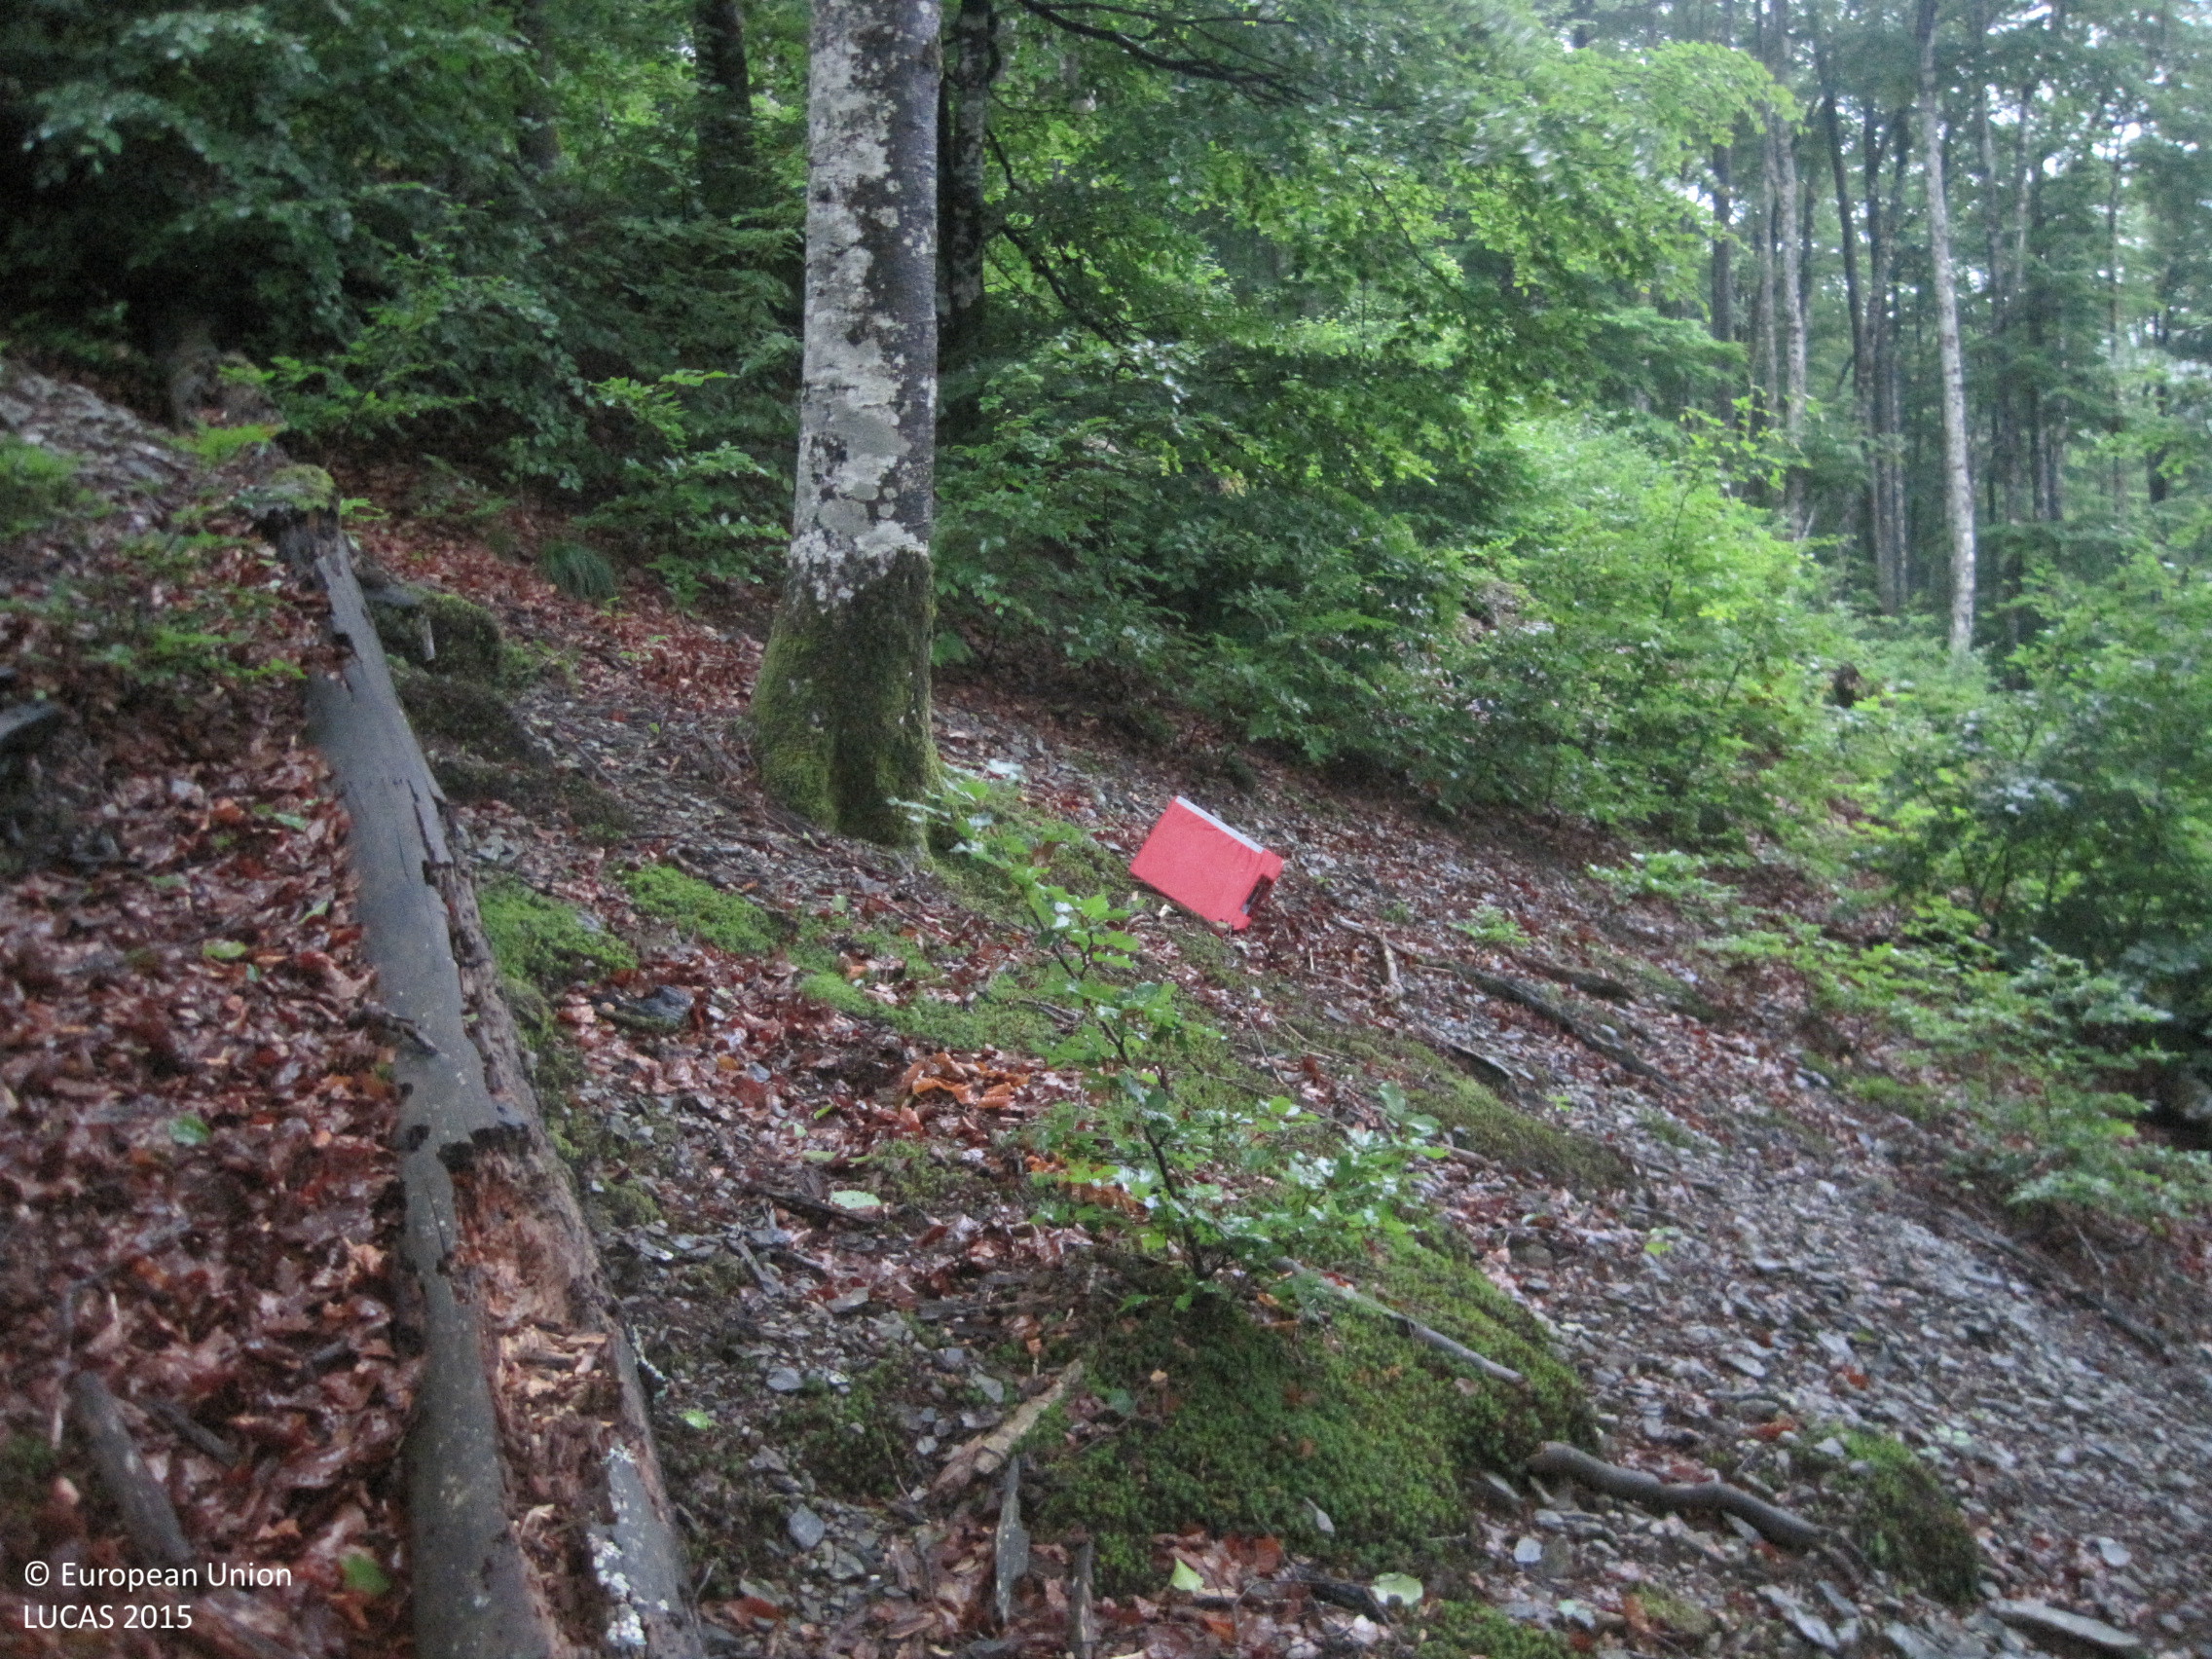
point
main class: Woodland
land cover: Broadleaved woodland
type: beech forest
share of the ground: > 75 %
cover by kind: broadleaved forest trees 100 %
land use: Forestry
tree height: > 5 m
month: June
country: ES
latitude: 43.0562
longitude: -1.7927
